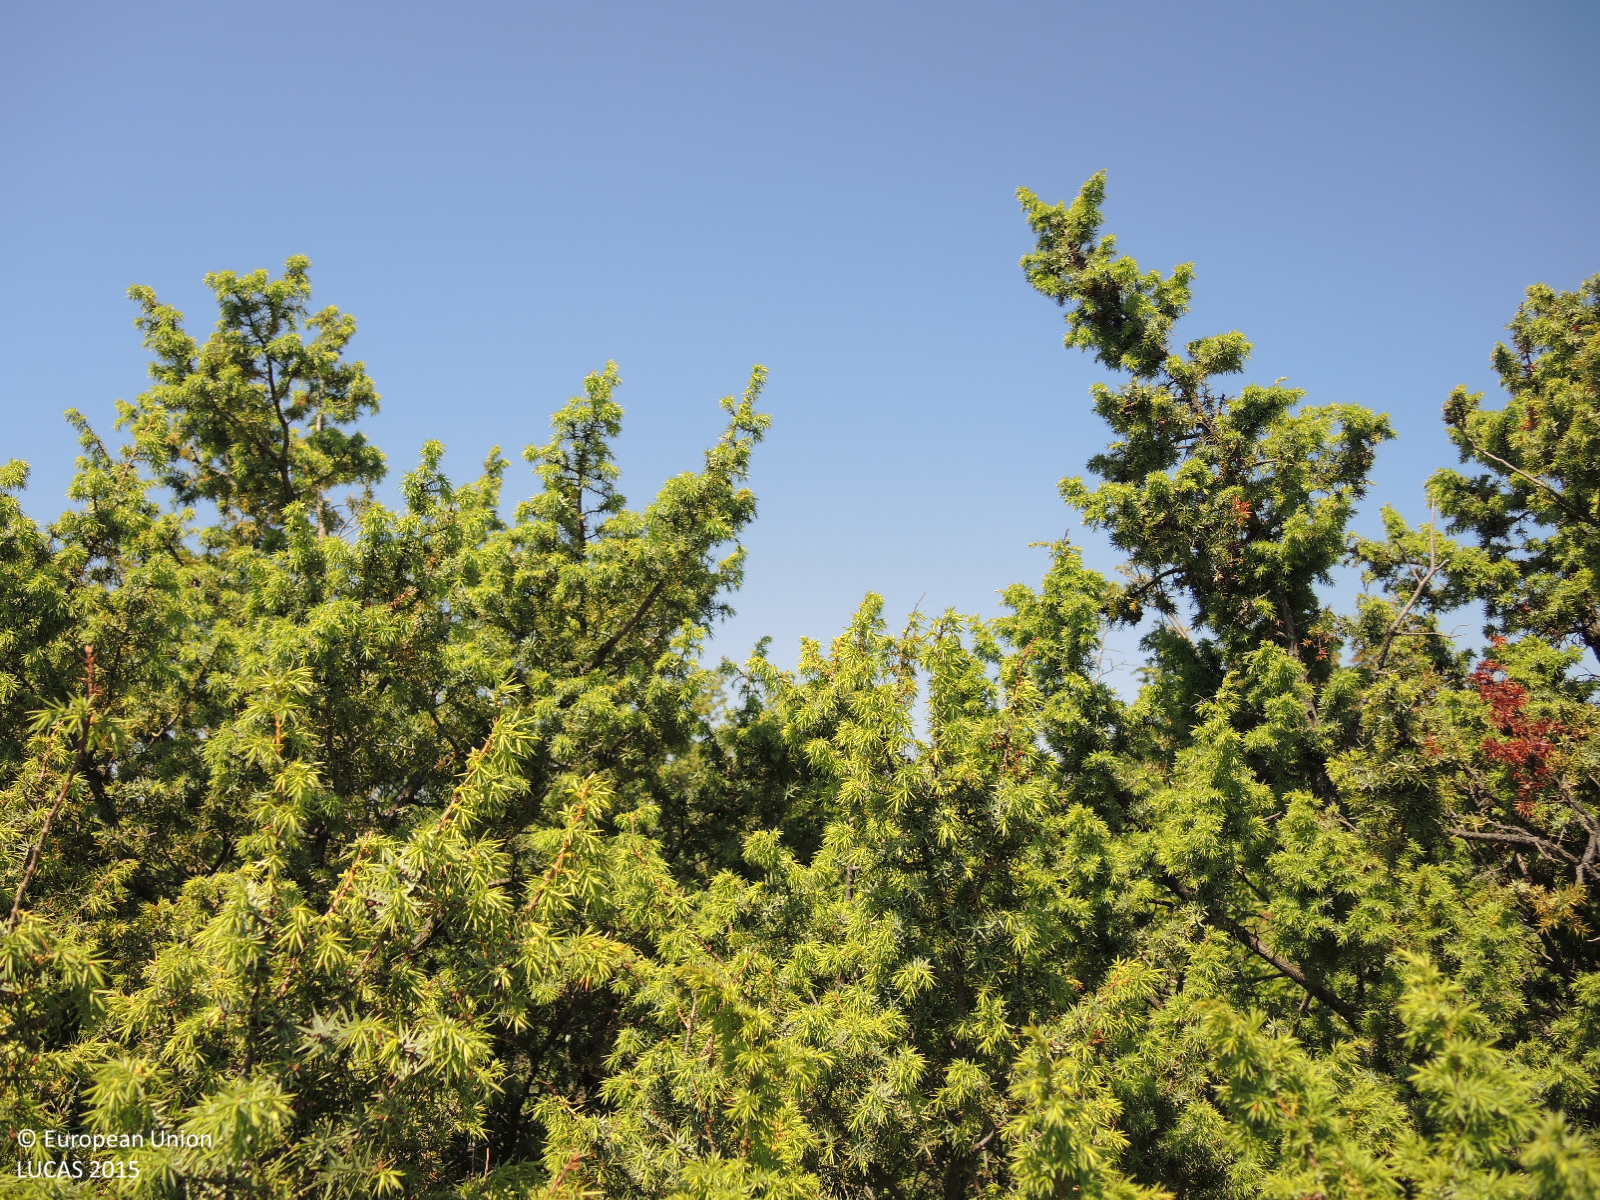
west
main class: Shrubland
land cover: Shrubland without tree cover
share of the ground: > 75 %
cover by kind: shrubs 90 %, unconsolidated bare surface 10 %
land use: Semi-natural and natural areas not in use
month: May
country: HR
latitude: 44.0301
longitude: 15.7190
